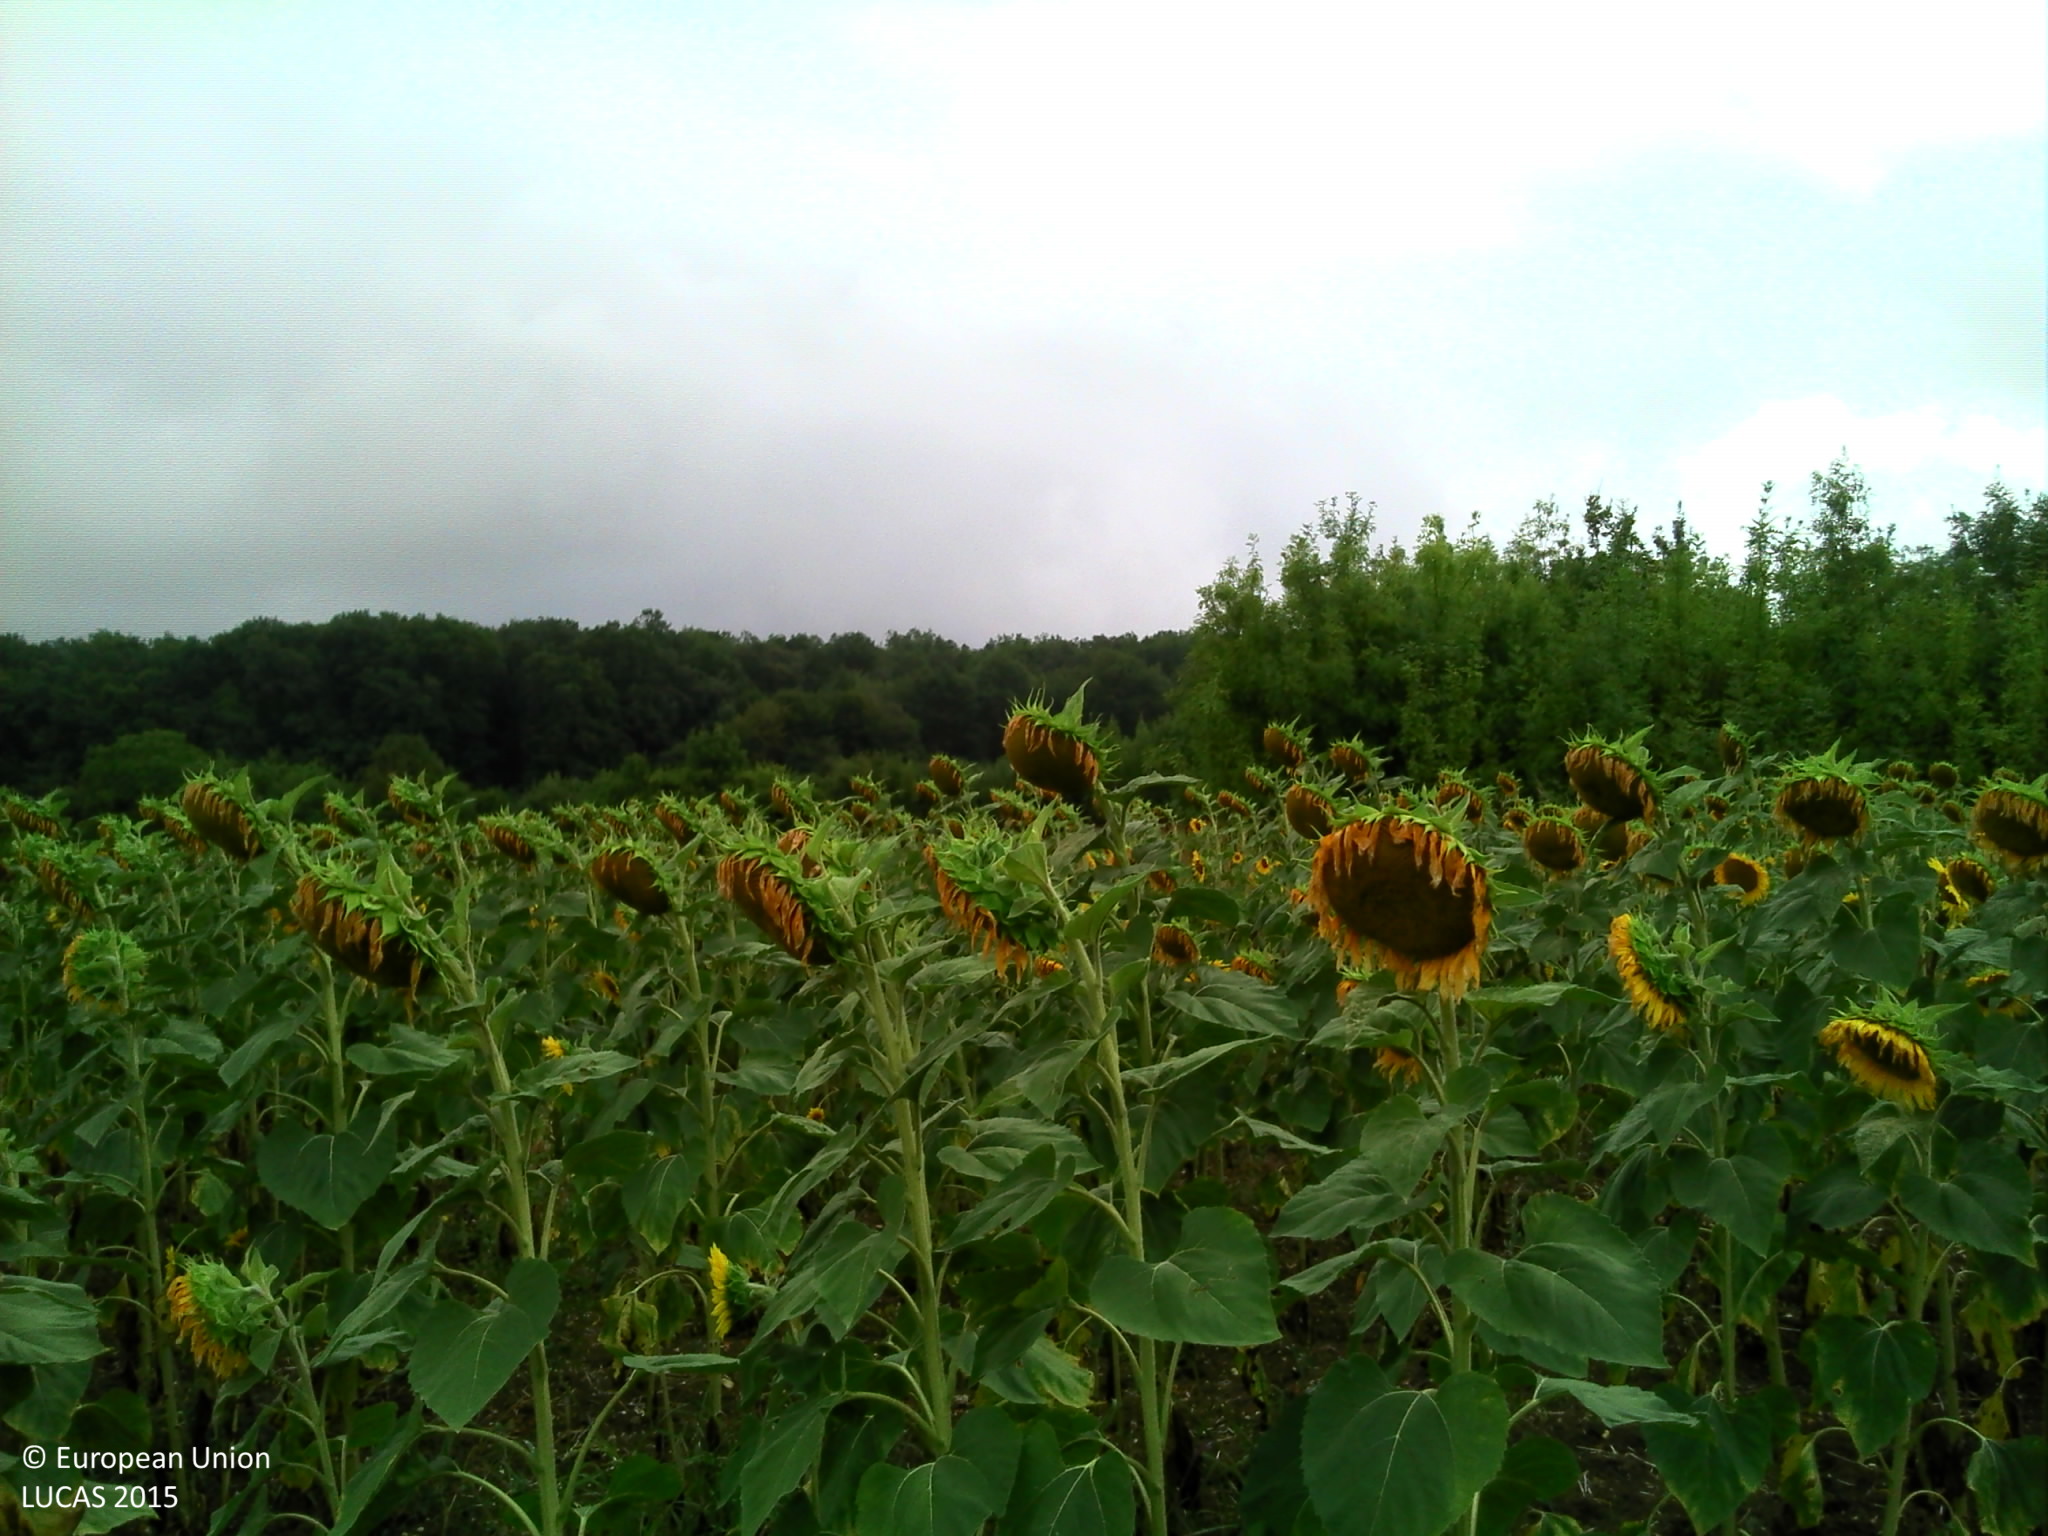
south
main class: Cropland
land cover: Sunflower
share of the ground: 50 - 75 %
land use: Agriculture (excluding fallow land and kitchen gardens)
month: August
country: FR
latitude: 44.6911
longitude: 0.8706
